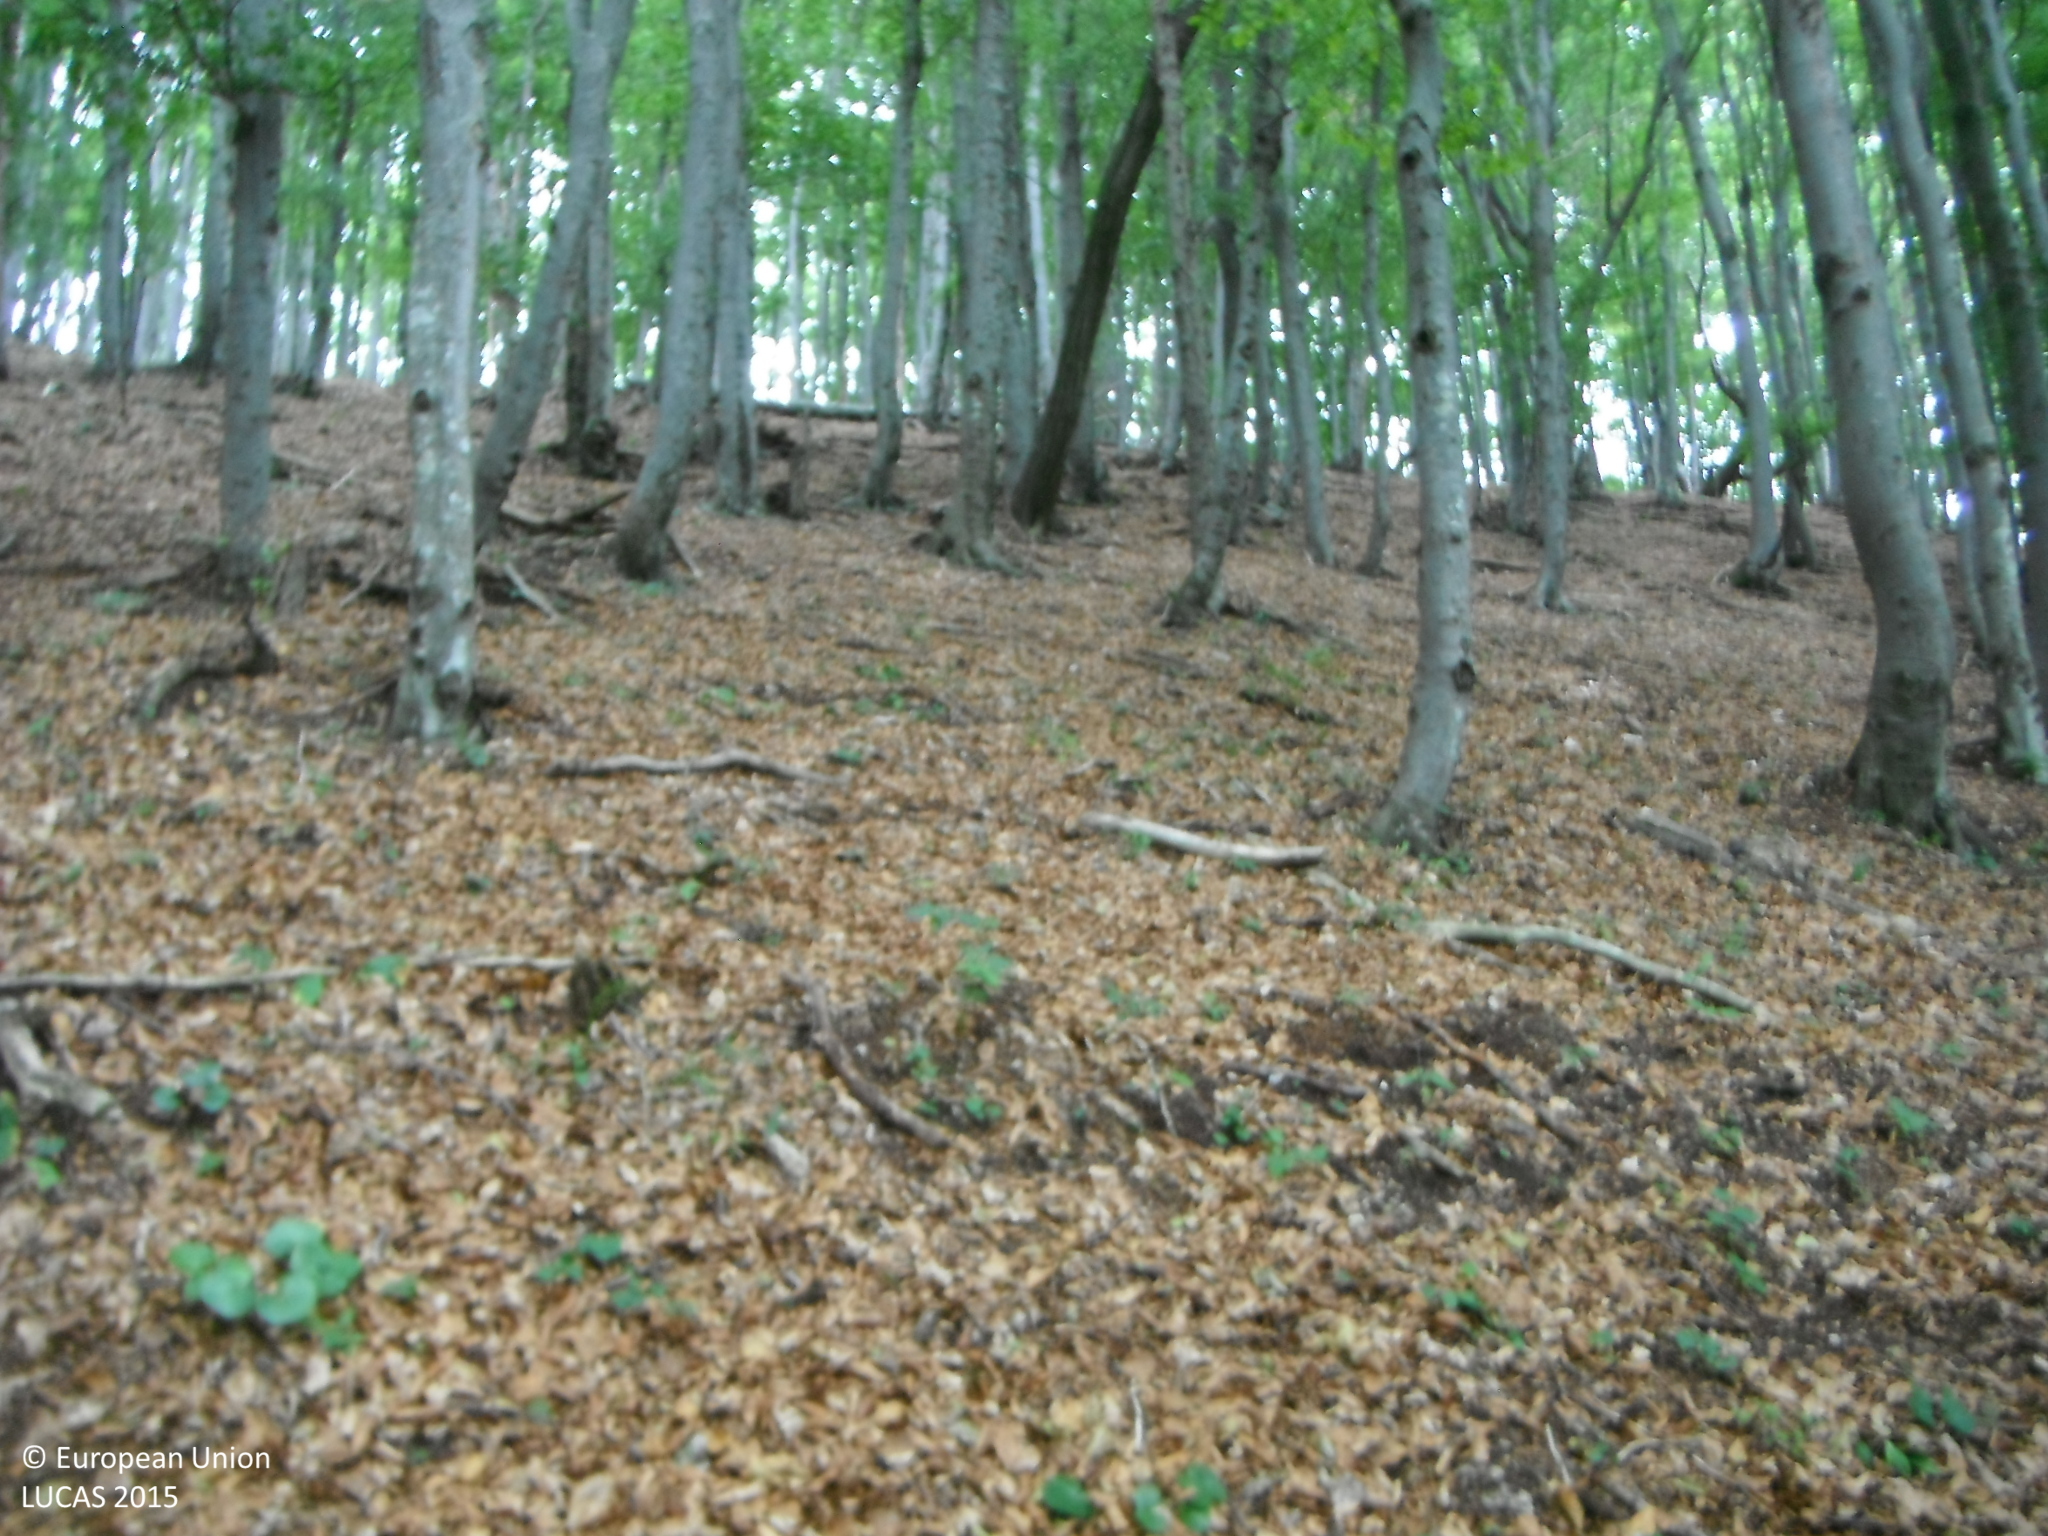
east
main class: Woodland
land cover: Broadleaved woodland
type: mountainous beech forest
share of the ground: > 75 %
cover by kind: broadleaved forest trees 85 %, herbaceous plants 5 %, consolidated bare surface 5 %
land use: Forestry
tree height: > 5 m
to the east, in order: Broadleaved woodland
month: September
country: SK
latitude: 48.9189
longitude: 18.3547
